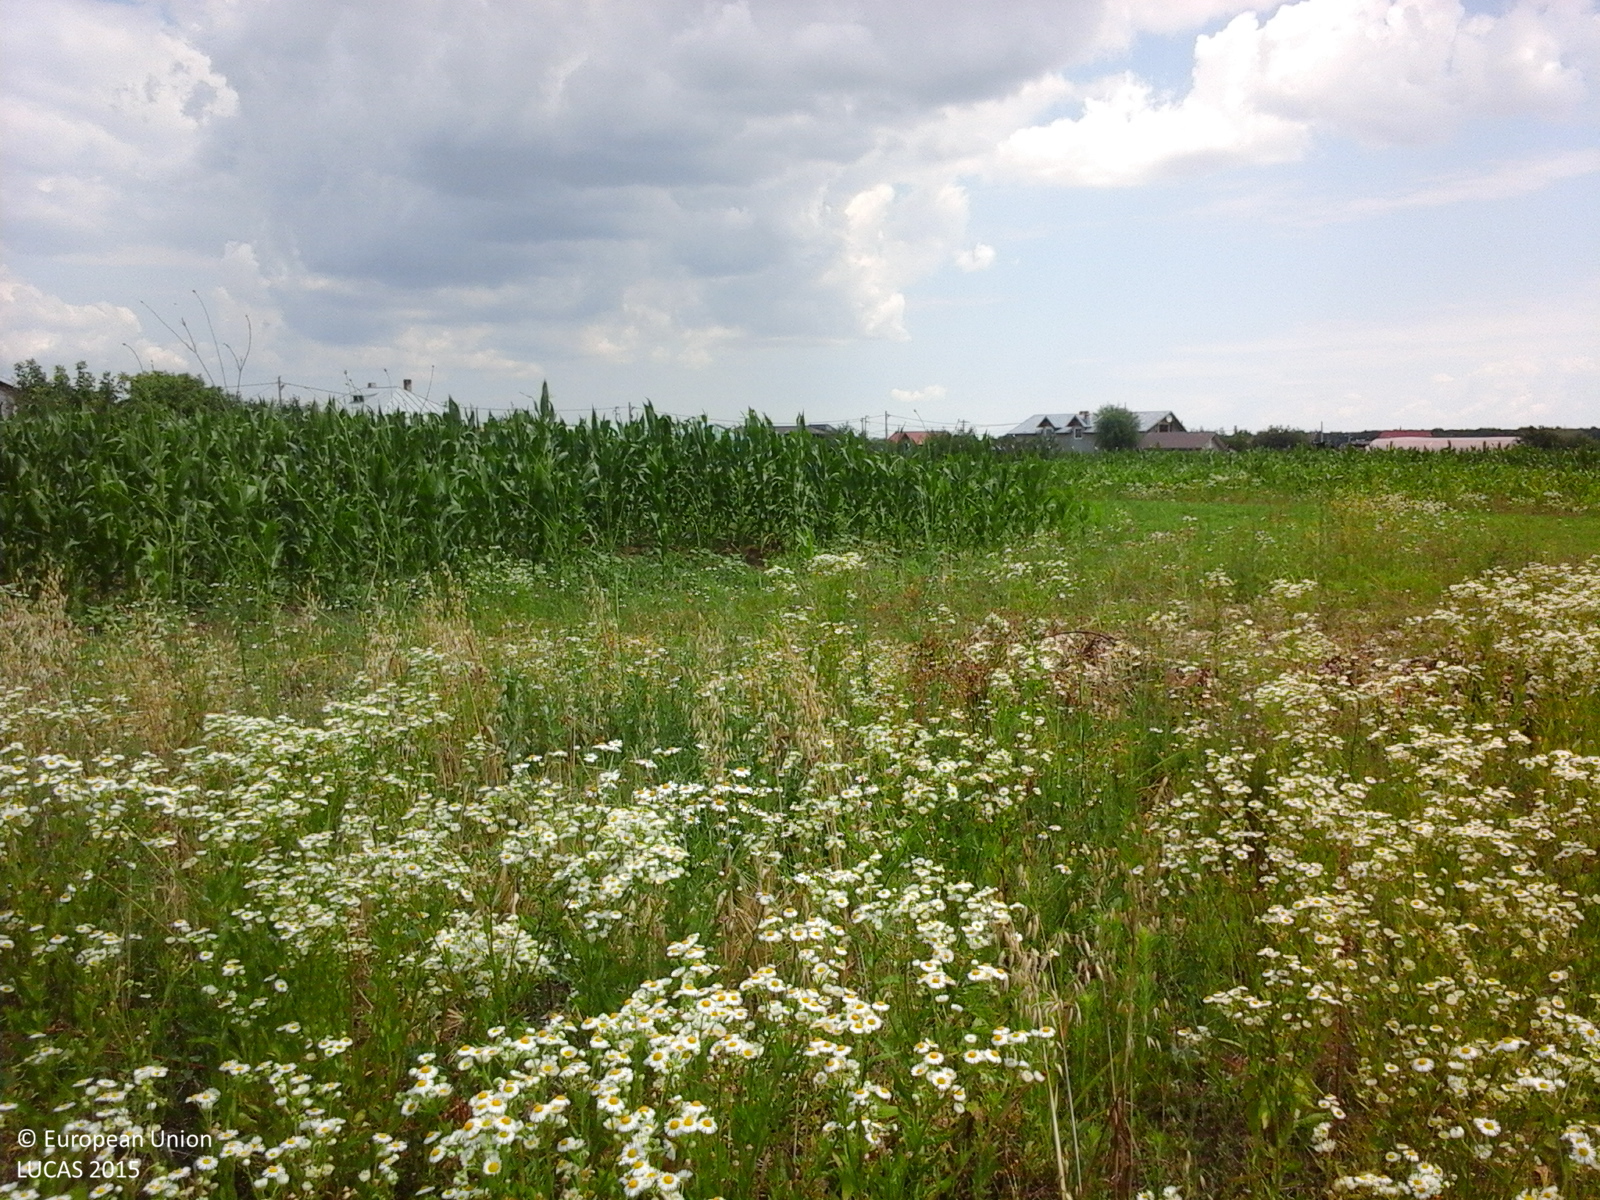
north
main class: Grassland
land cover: Spontaneously vegetated surfaces
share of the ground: > 75 %
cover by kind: herbaceous plants 100 %
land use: Agriculture (excluding fallow land and kitchen gardens)
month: June
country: RO
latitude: 44.6412
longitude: 26.2354
